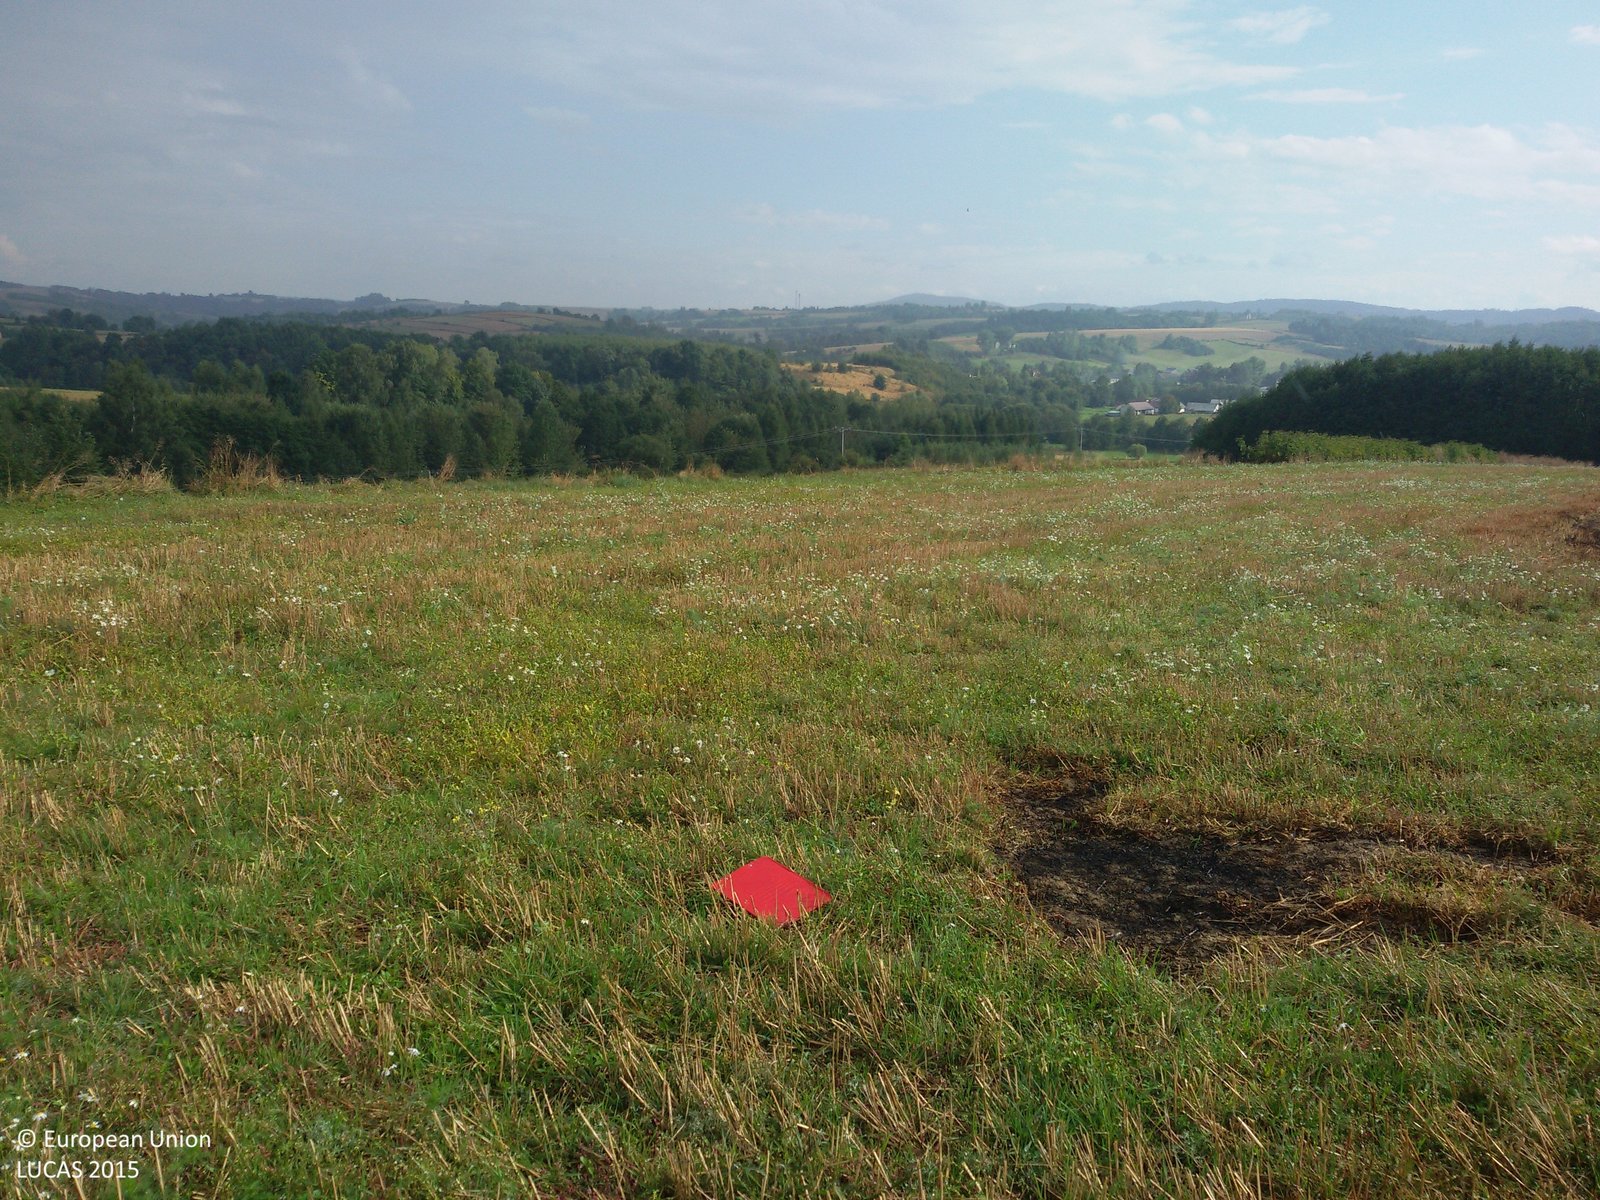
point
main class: Cropland
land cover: Rye
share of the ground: 25 - 50 %
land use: Agriculture (excluding fallow land and kitchen gardens)
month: September
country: PL
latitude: 49.9153
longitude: 21.2577
